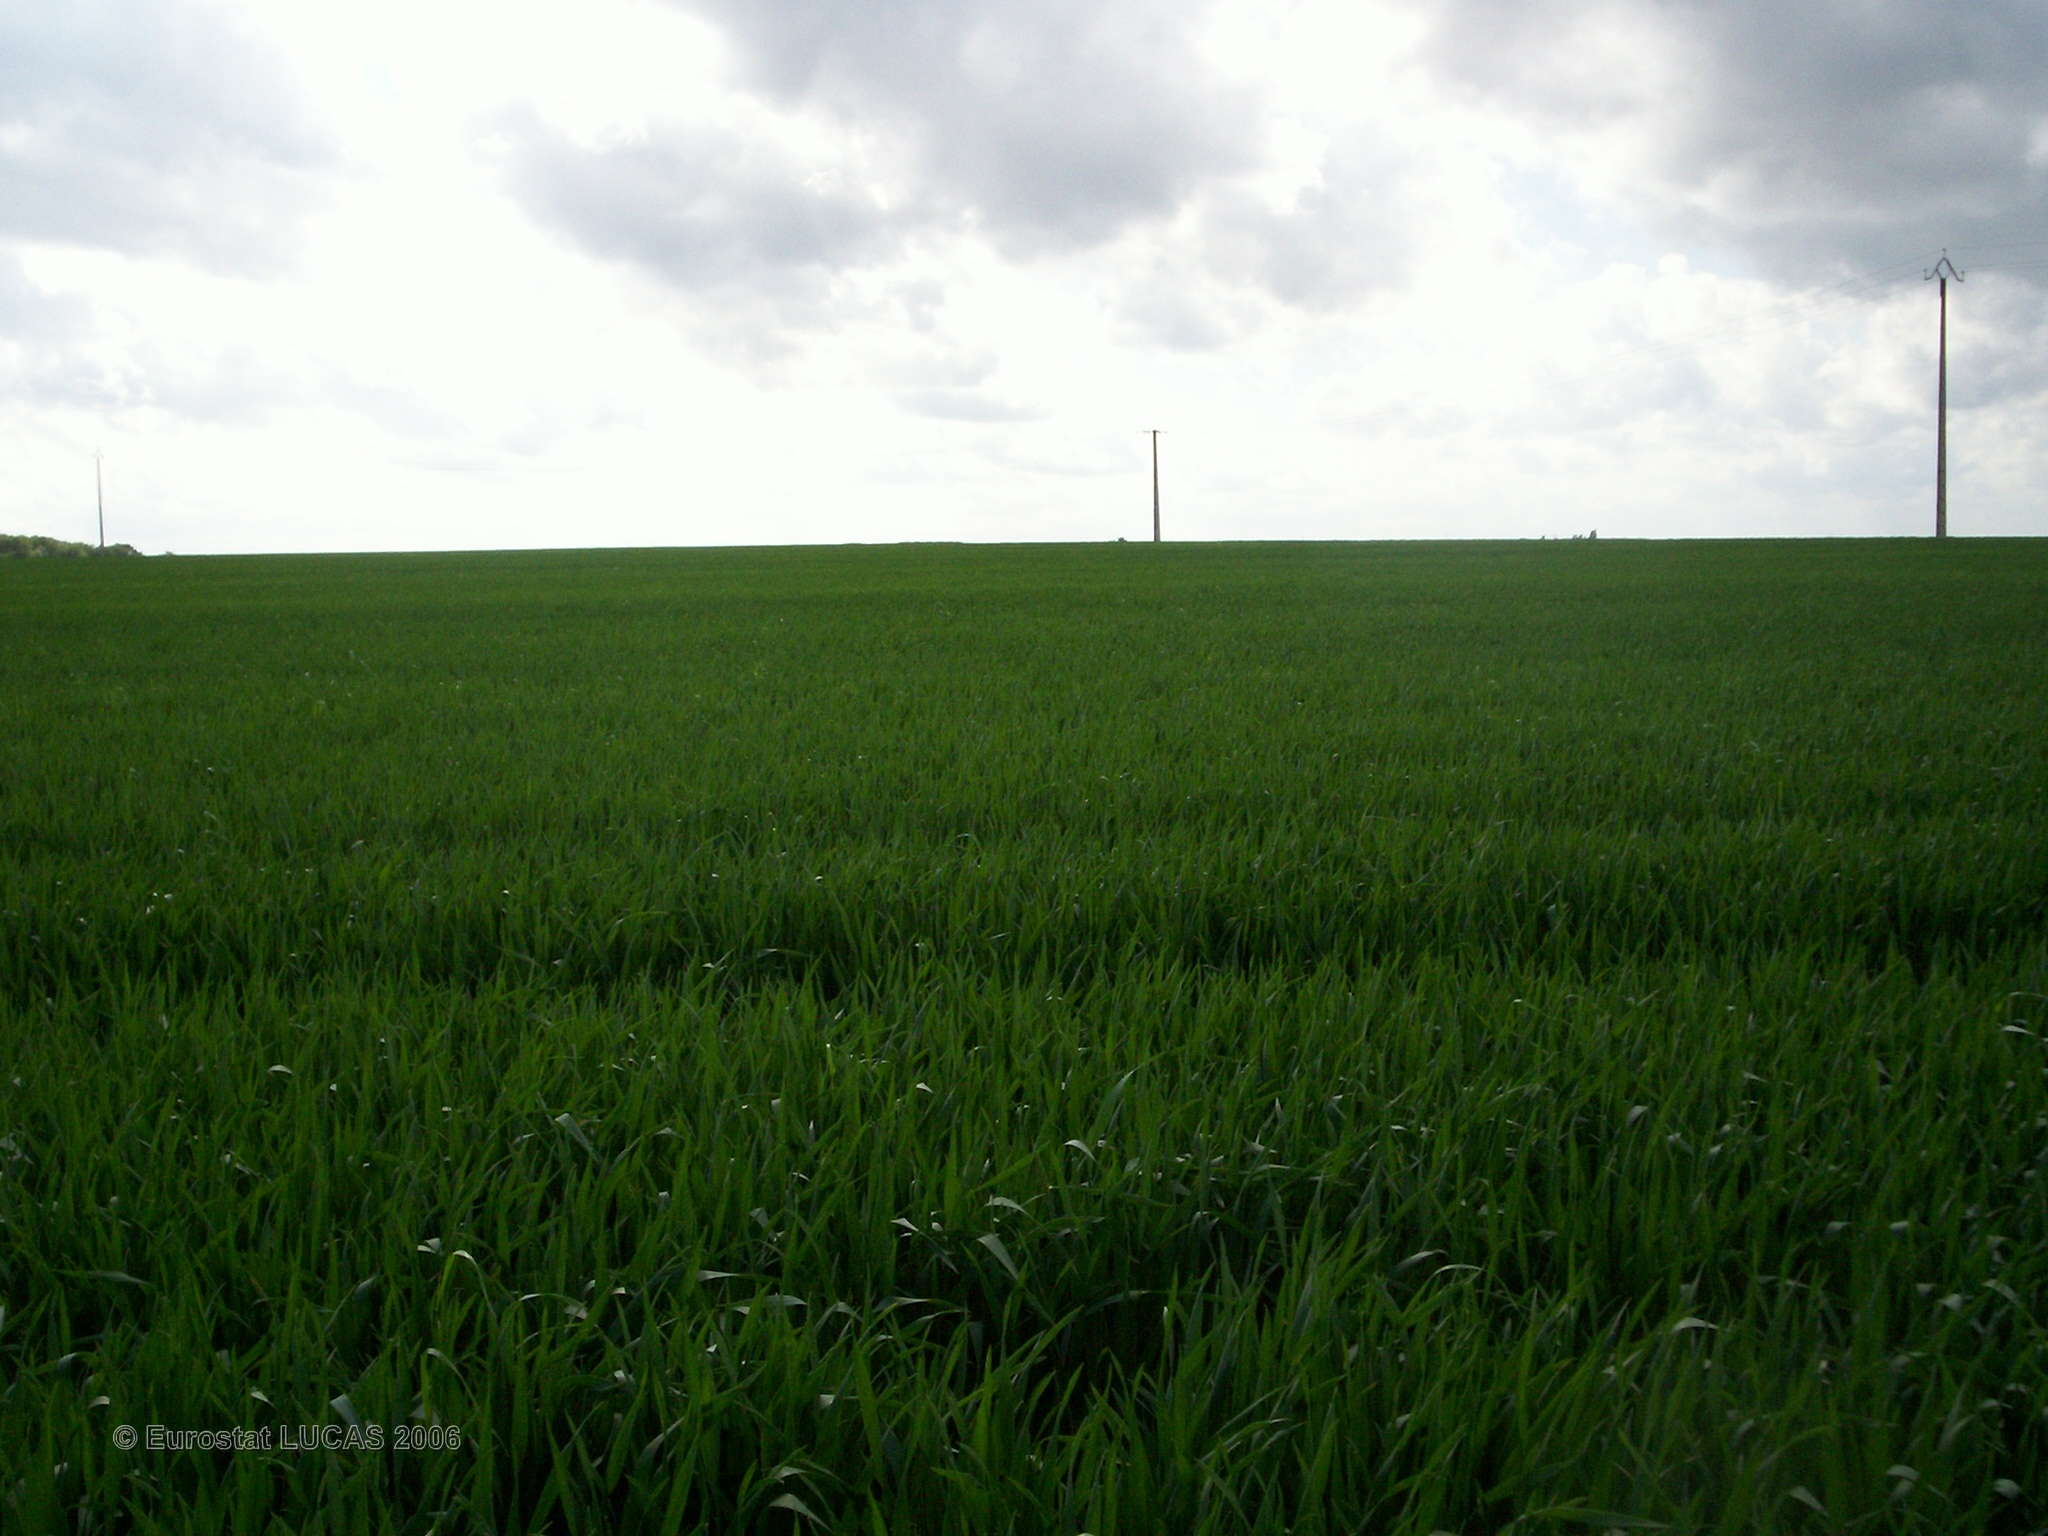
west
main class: Cropland
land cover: Common wheat
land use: Agriculture (excluding fallow land and kitchen gardens)
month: May
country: FR
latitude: 47.7782
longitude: 2.9066
